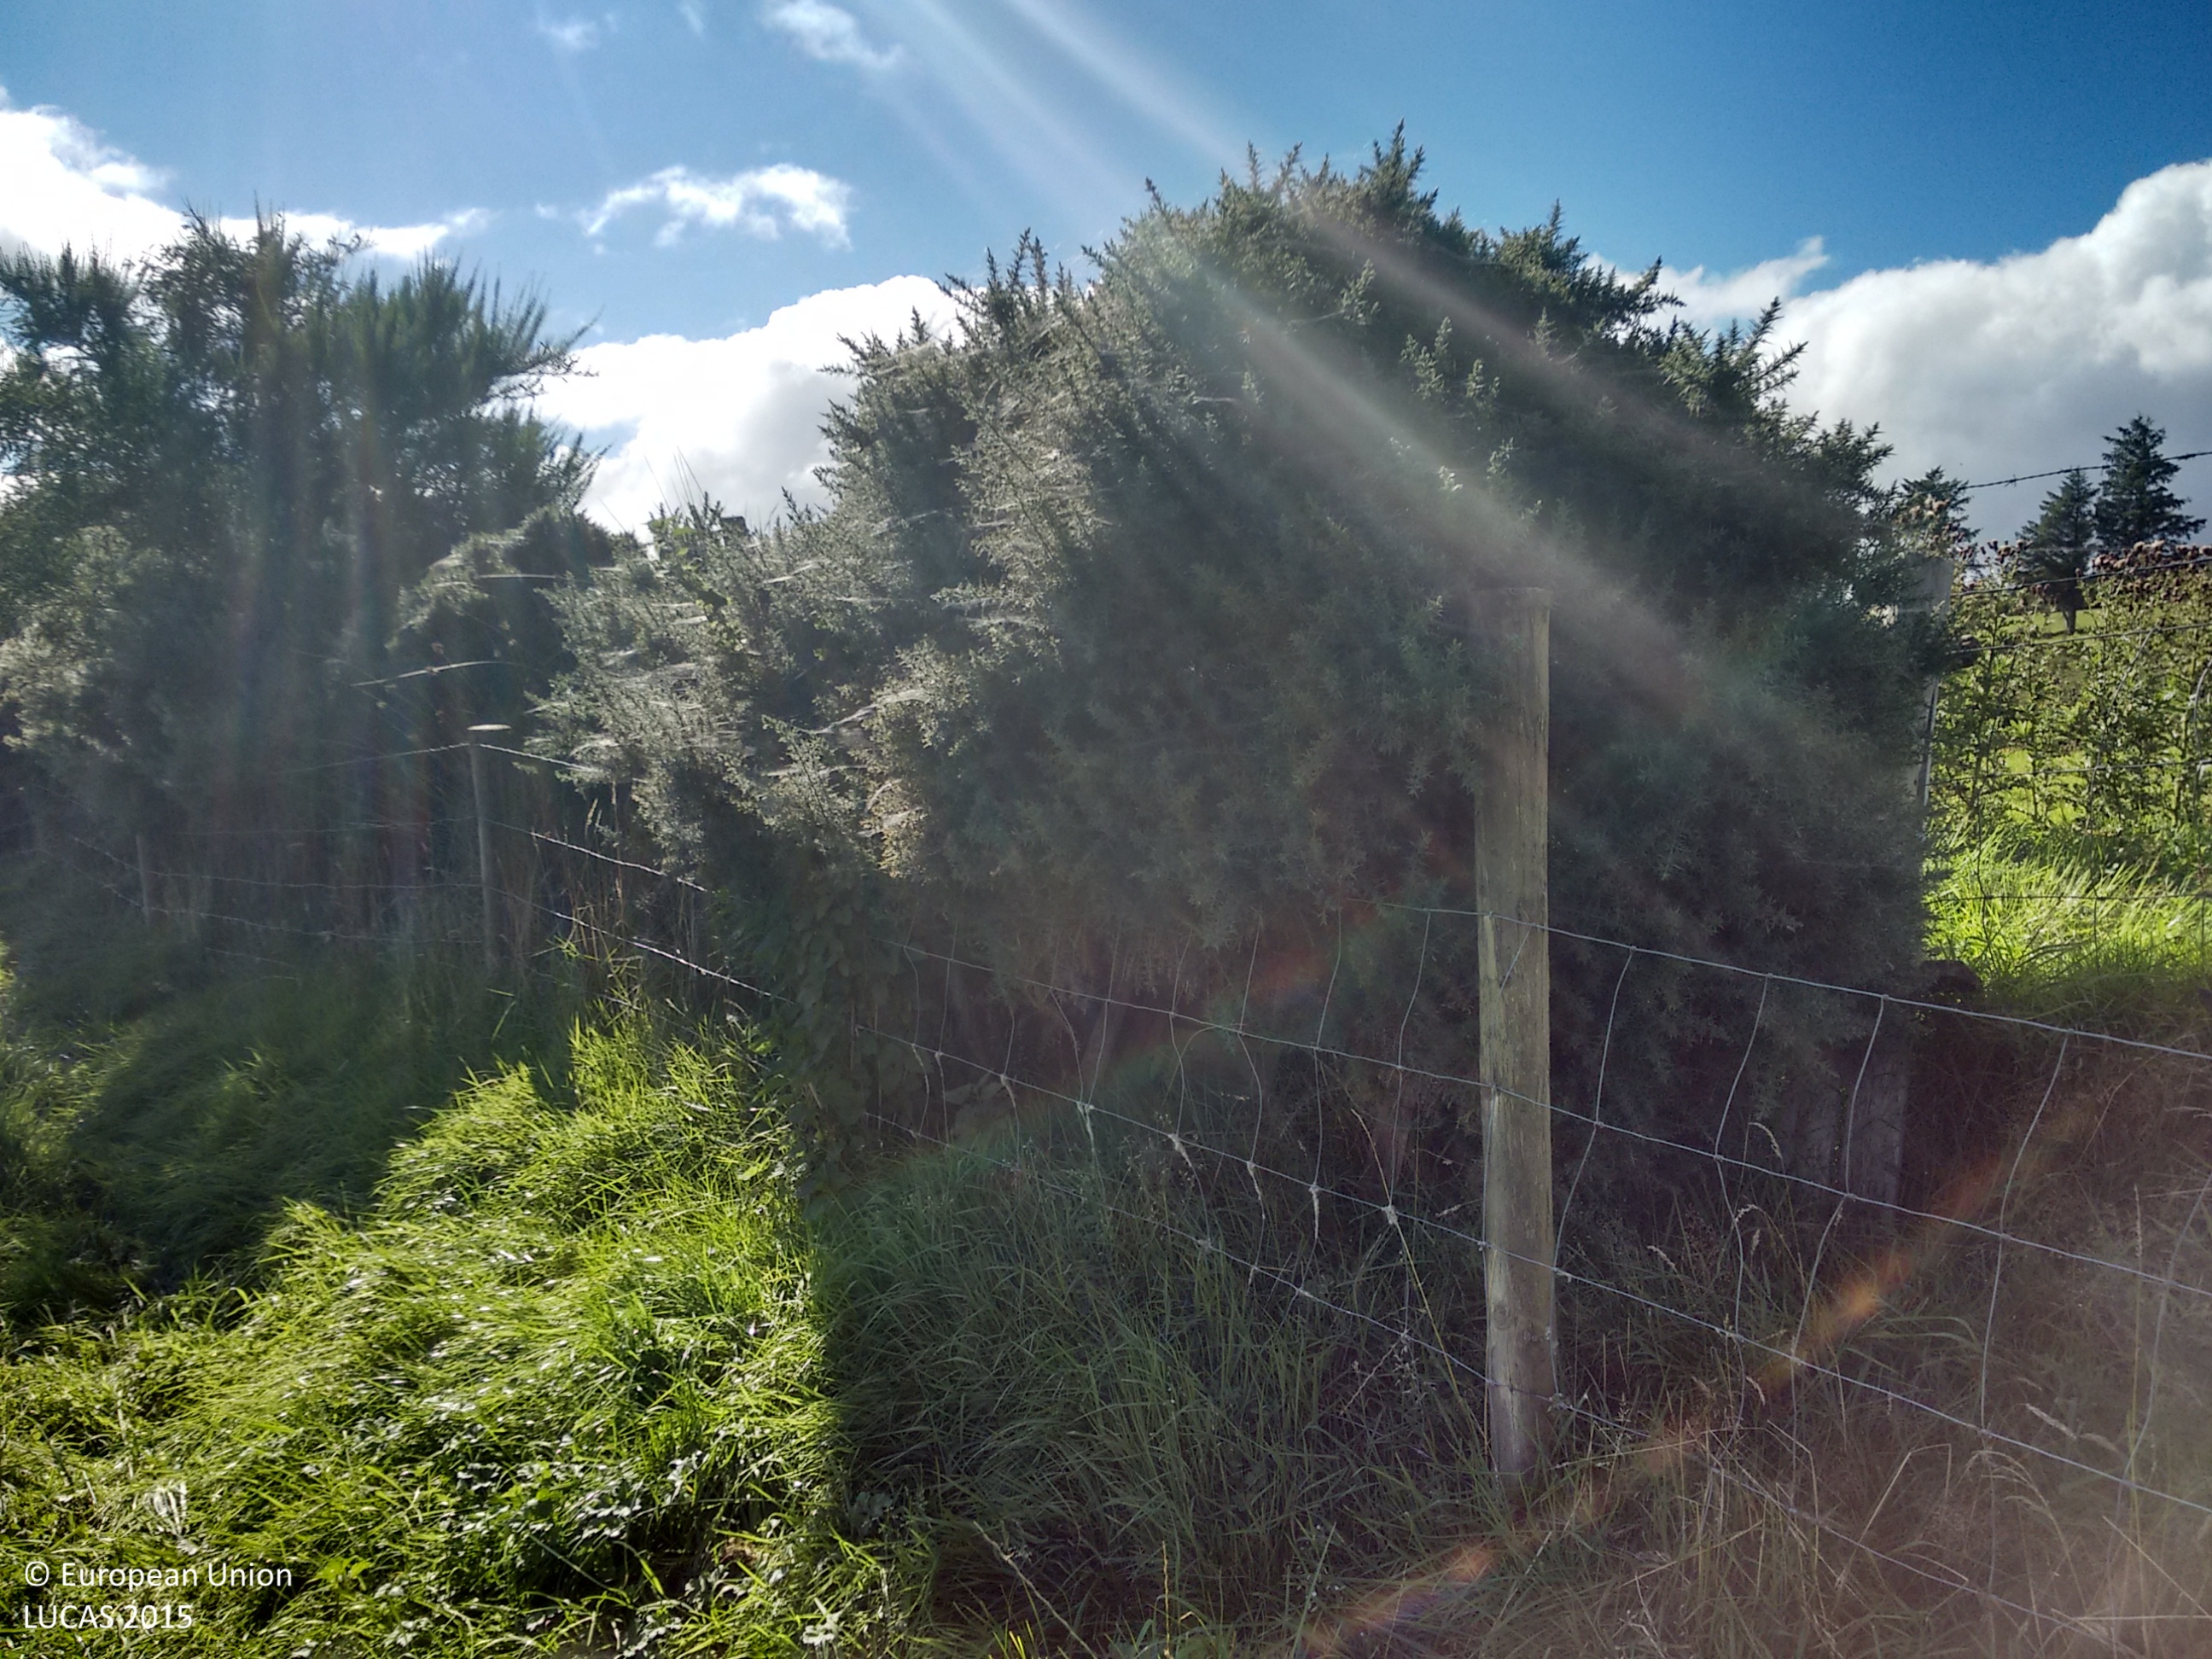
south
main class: Grassland
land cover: Grassland without tree/shrub cover
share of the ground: > 75 %
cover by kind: herbaceous plants 100 %
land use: Agriculture (excluding fallow land and kitchen gardens)
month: September
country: IE
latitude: 55.1379
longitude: -7.2276
